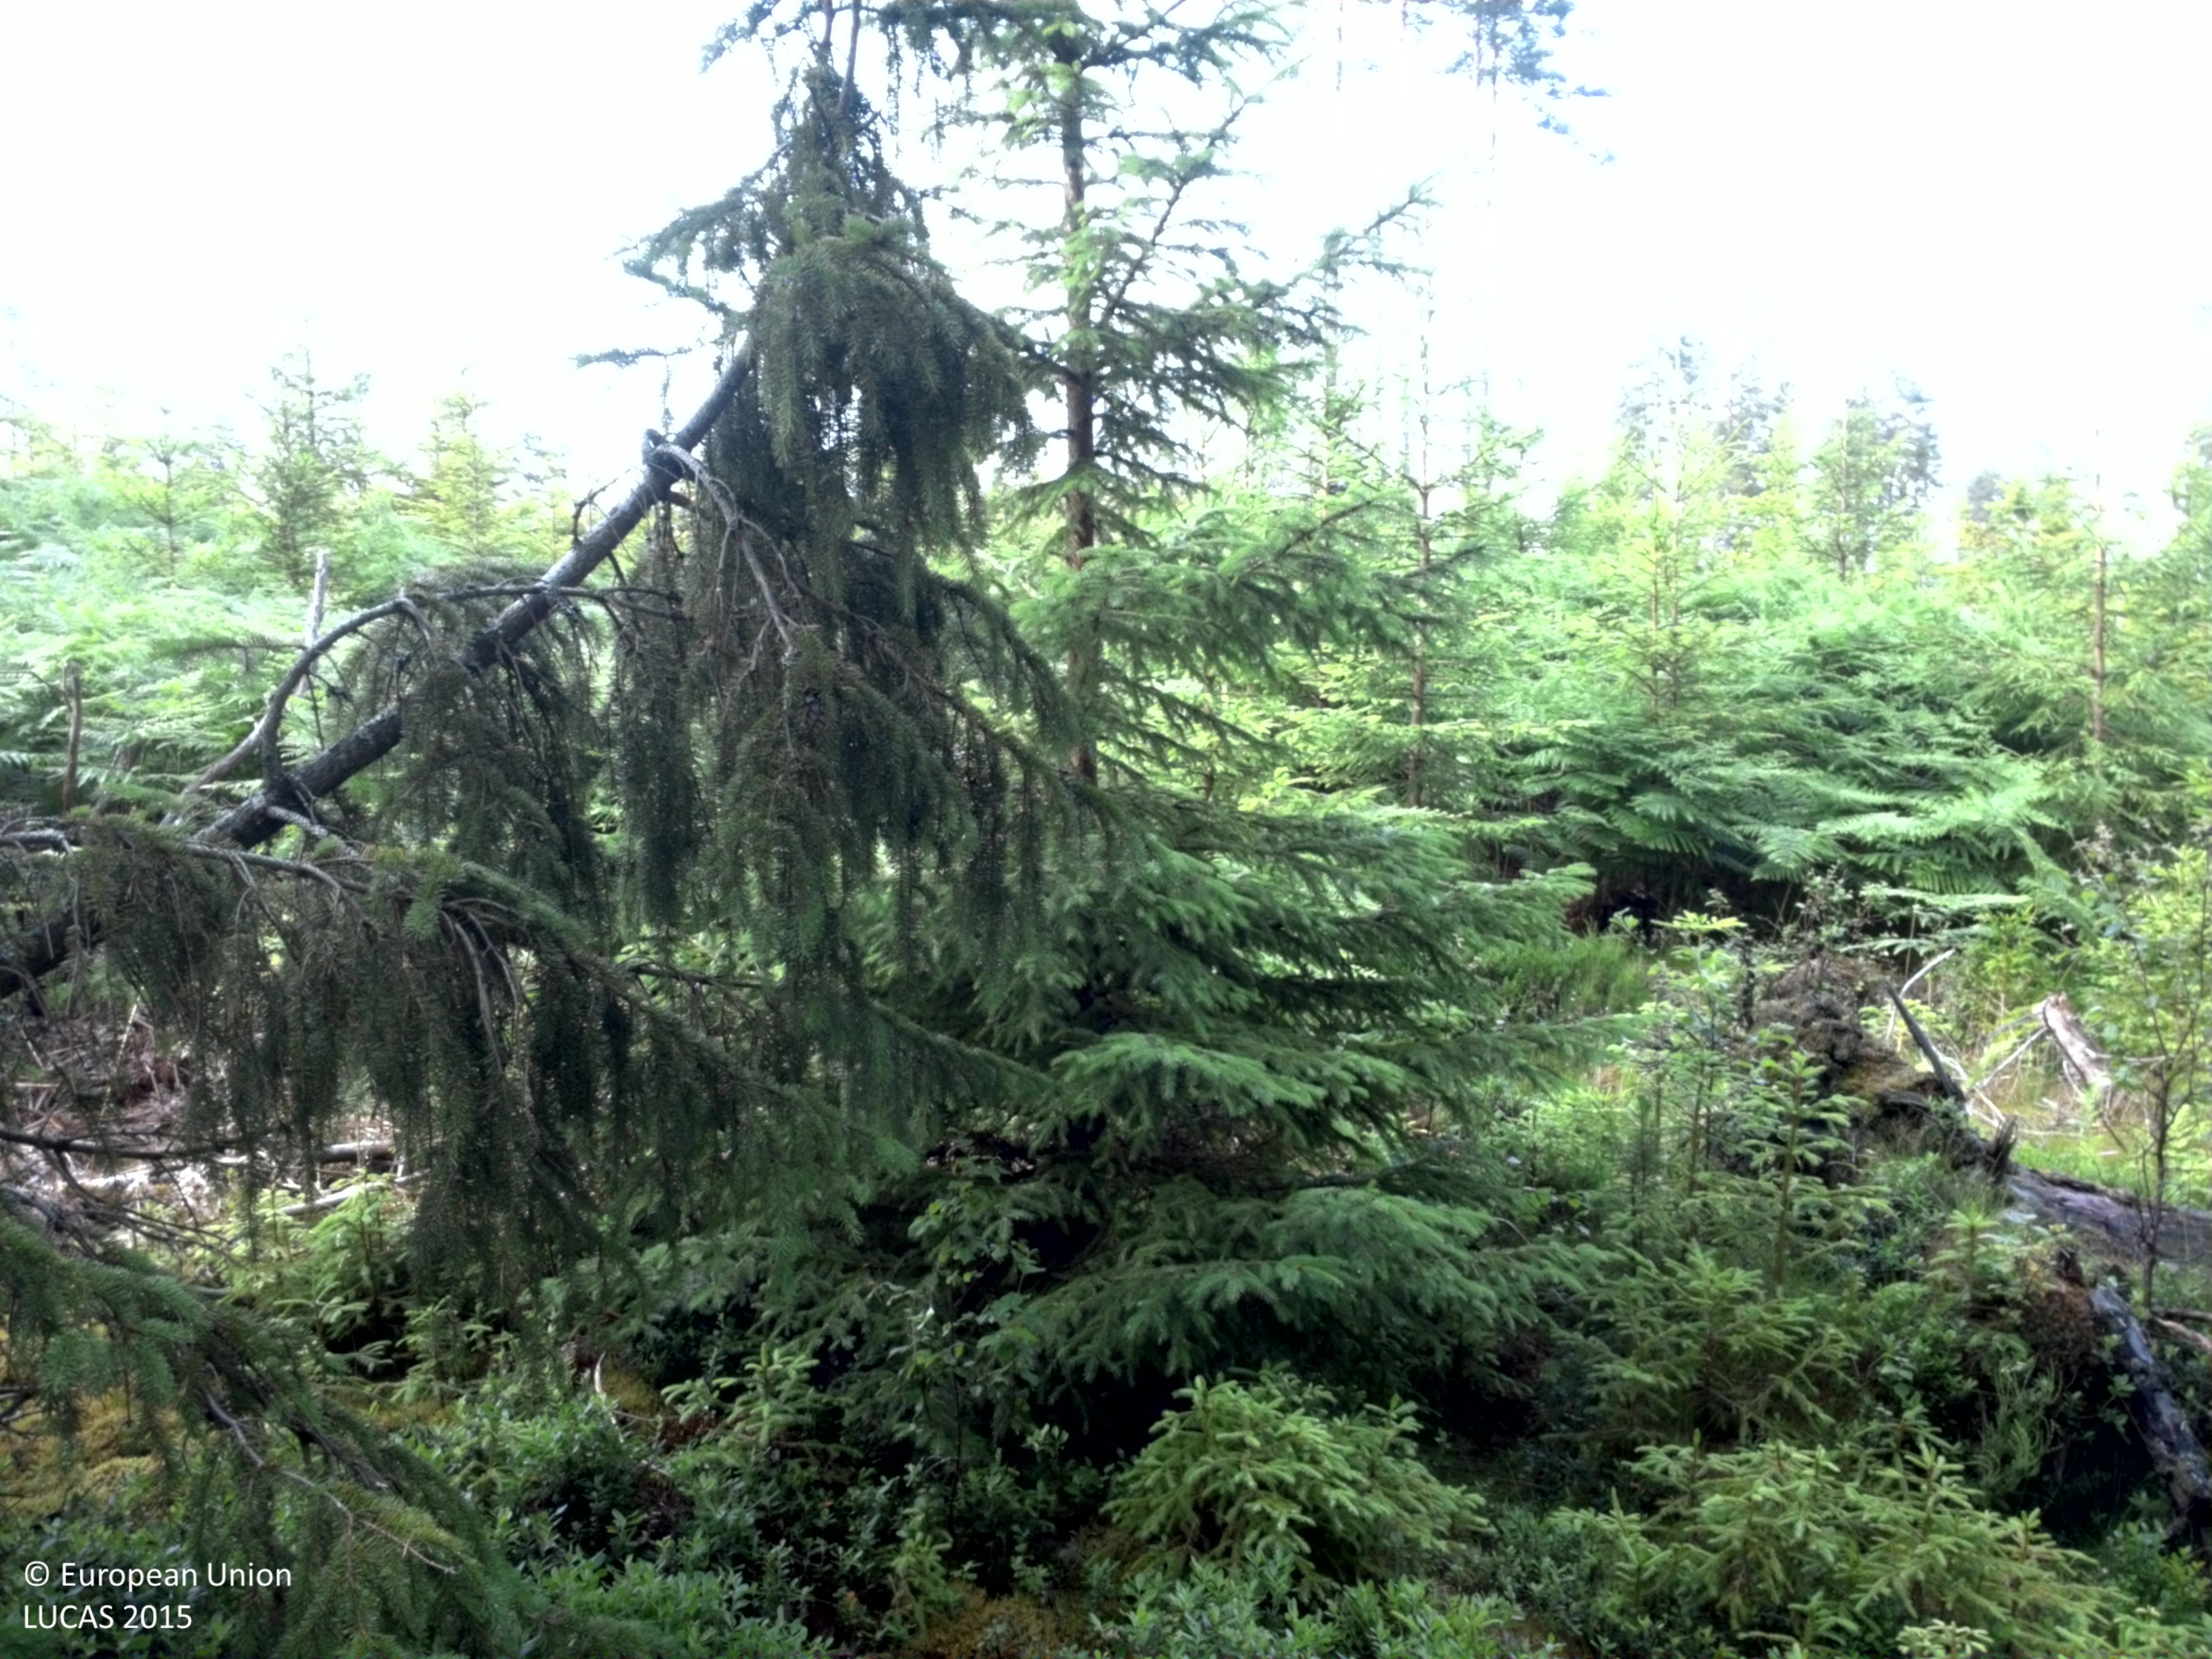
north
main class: Woodland
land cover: Pine dominated coniferous woodland
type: boreal forest
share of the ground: > 75 %
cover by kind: coniferous forest trees 70 %, shrubs 20 %, broadleaved forest trees 10 %
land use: Forestry
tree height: > 5 m
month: July
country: SE
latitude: 59.4544
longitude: 14.6658
